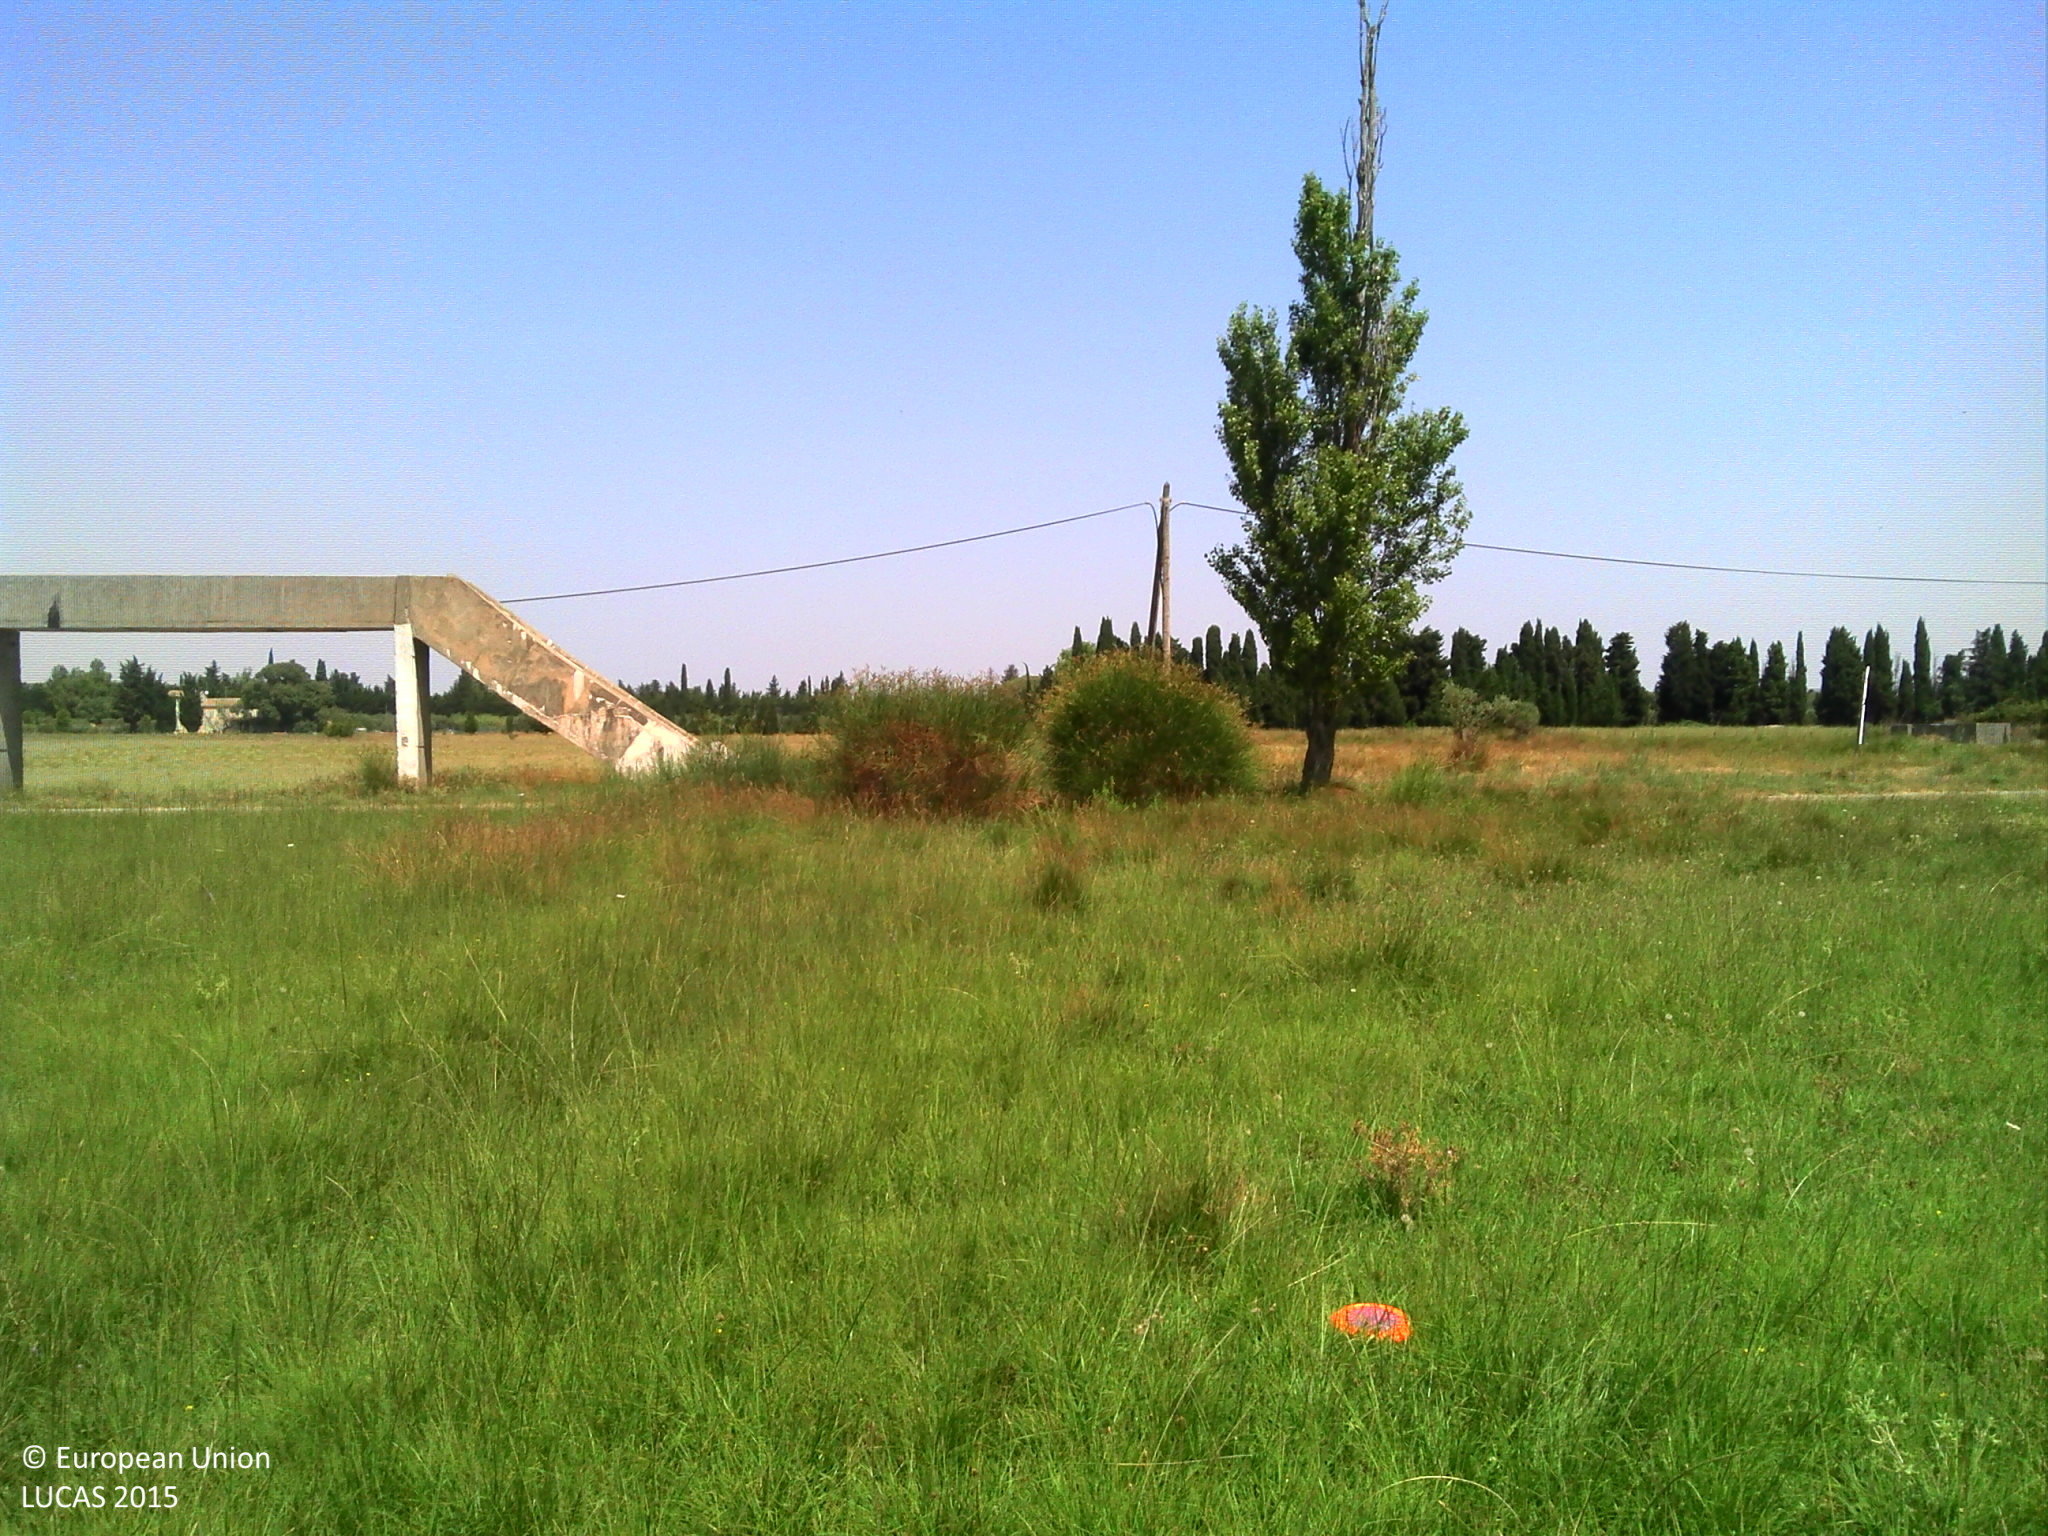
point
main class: Grassland
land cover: Grassland without tree/shrub cover
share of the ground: > 75 %
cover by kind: herbaceous plants 100 %
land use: Agriculture (excluding fallow land and kitchen gardens)
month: July
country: FR
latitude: 43.6723
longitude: 4.6886
